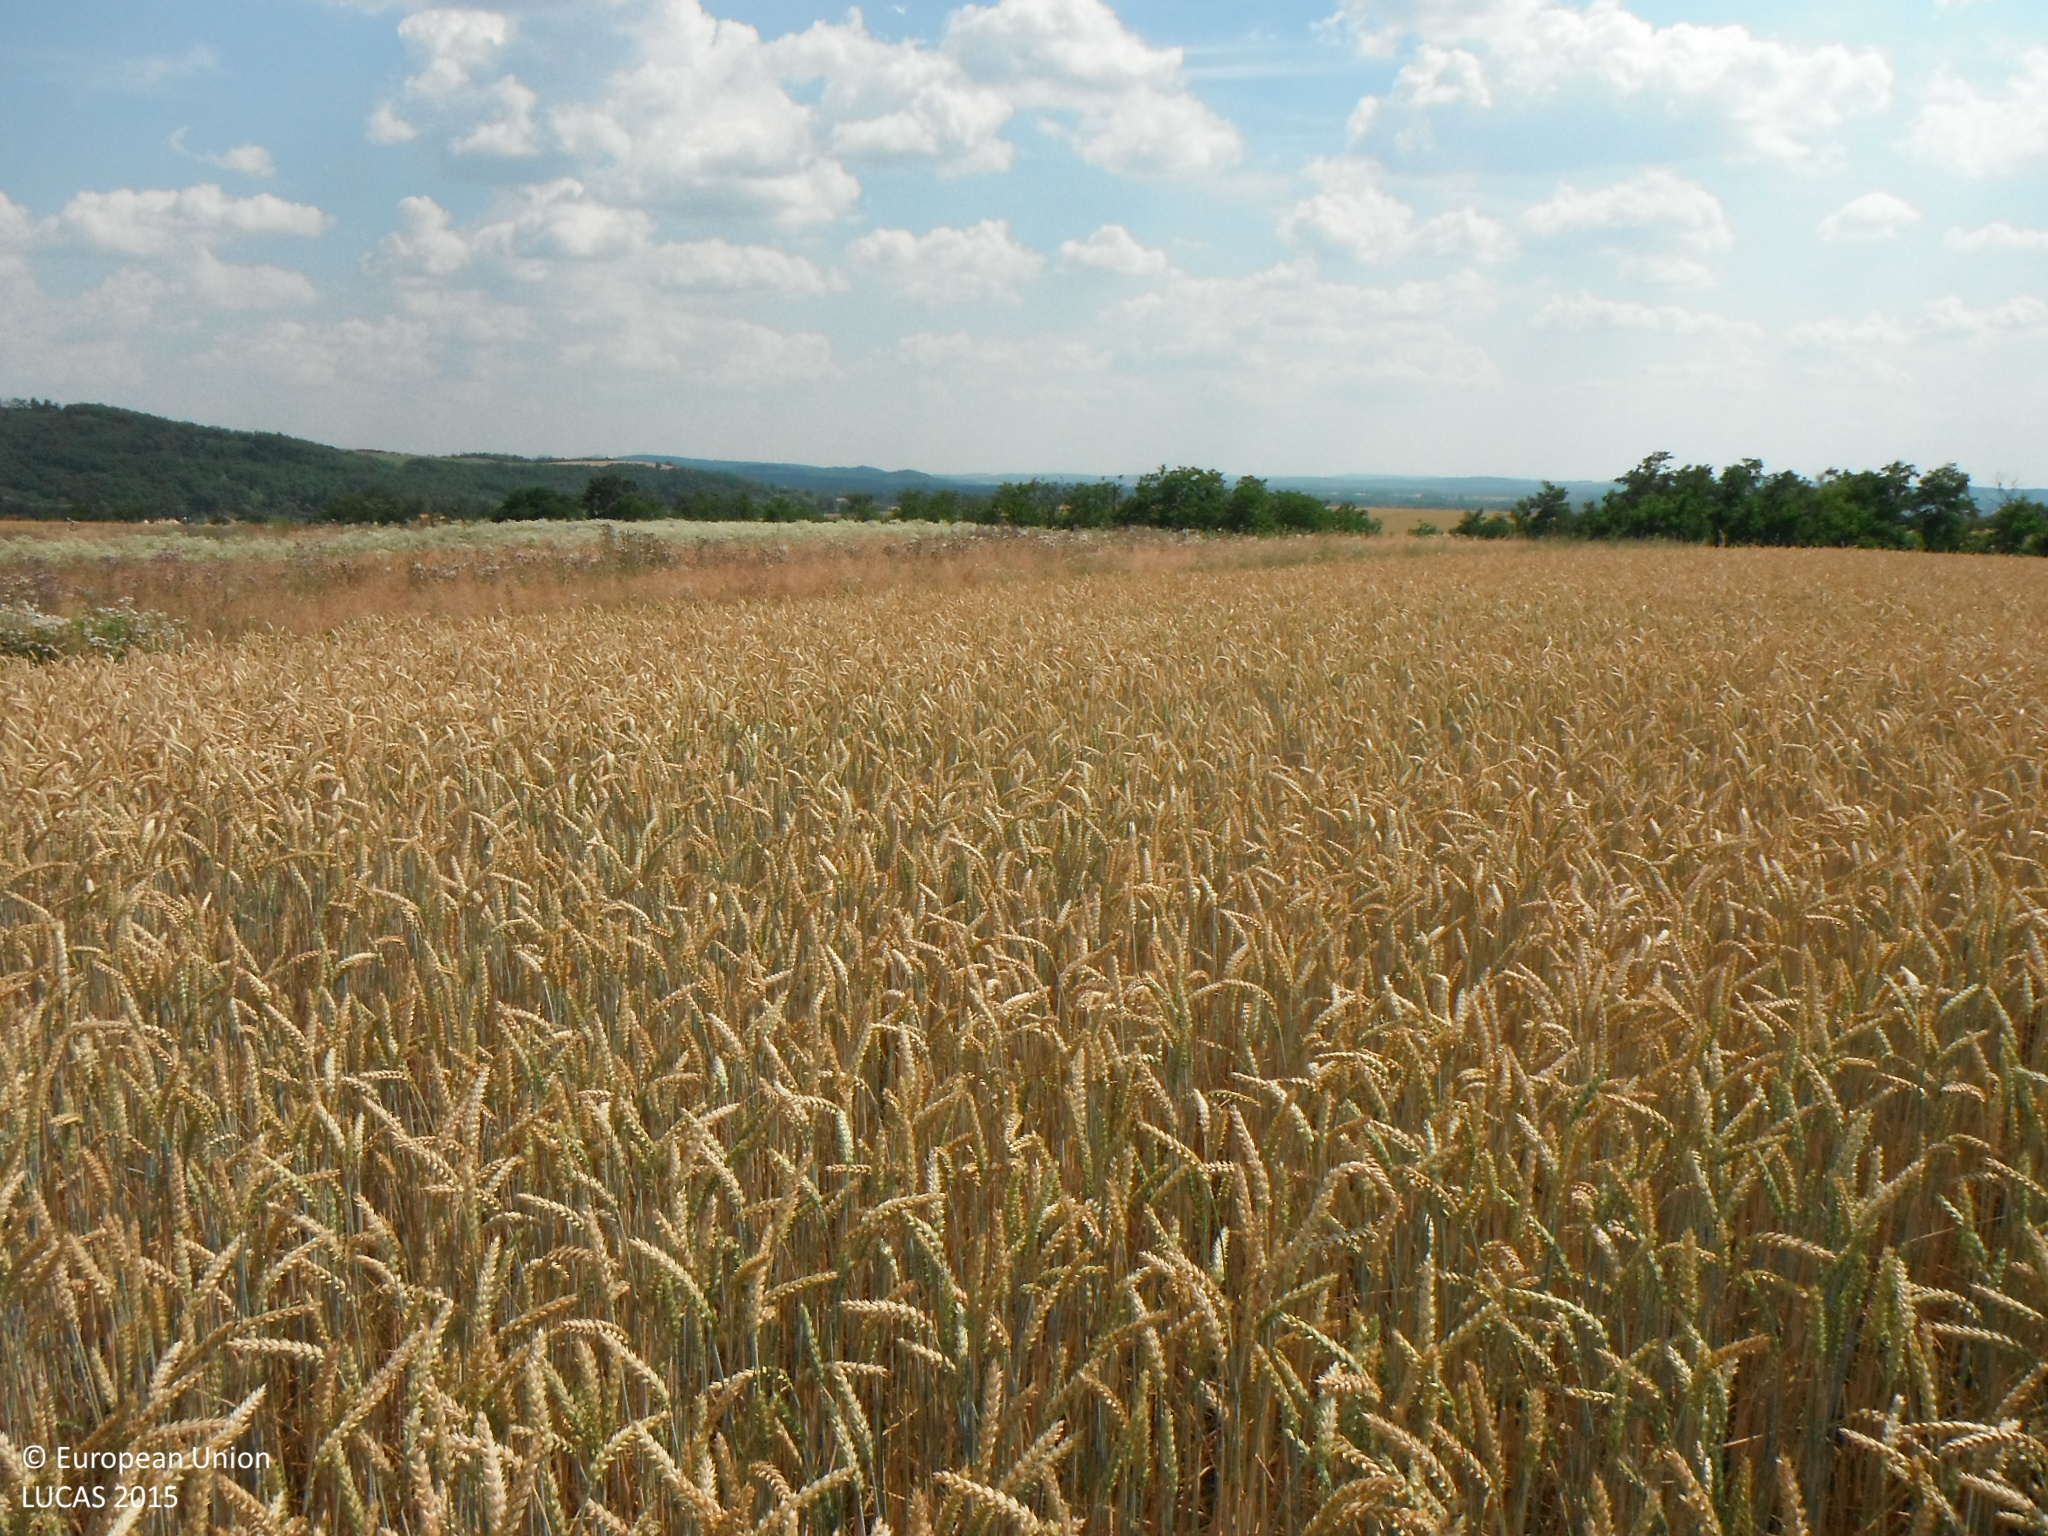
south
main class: Cropland
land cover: Common wheat
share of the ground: > 75 %
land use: Agriculture (excluding fallow land and kitchen gardens)
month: July
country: SK
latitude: 48.1168
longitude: 19.3312
